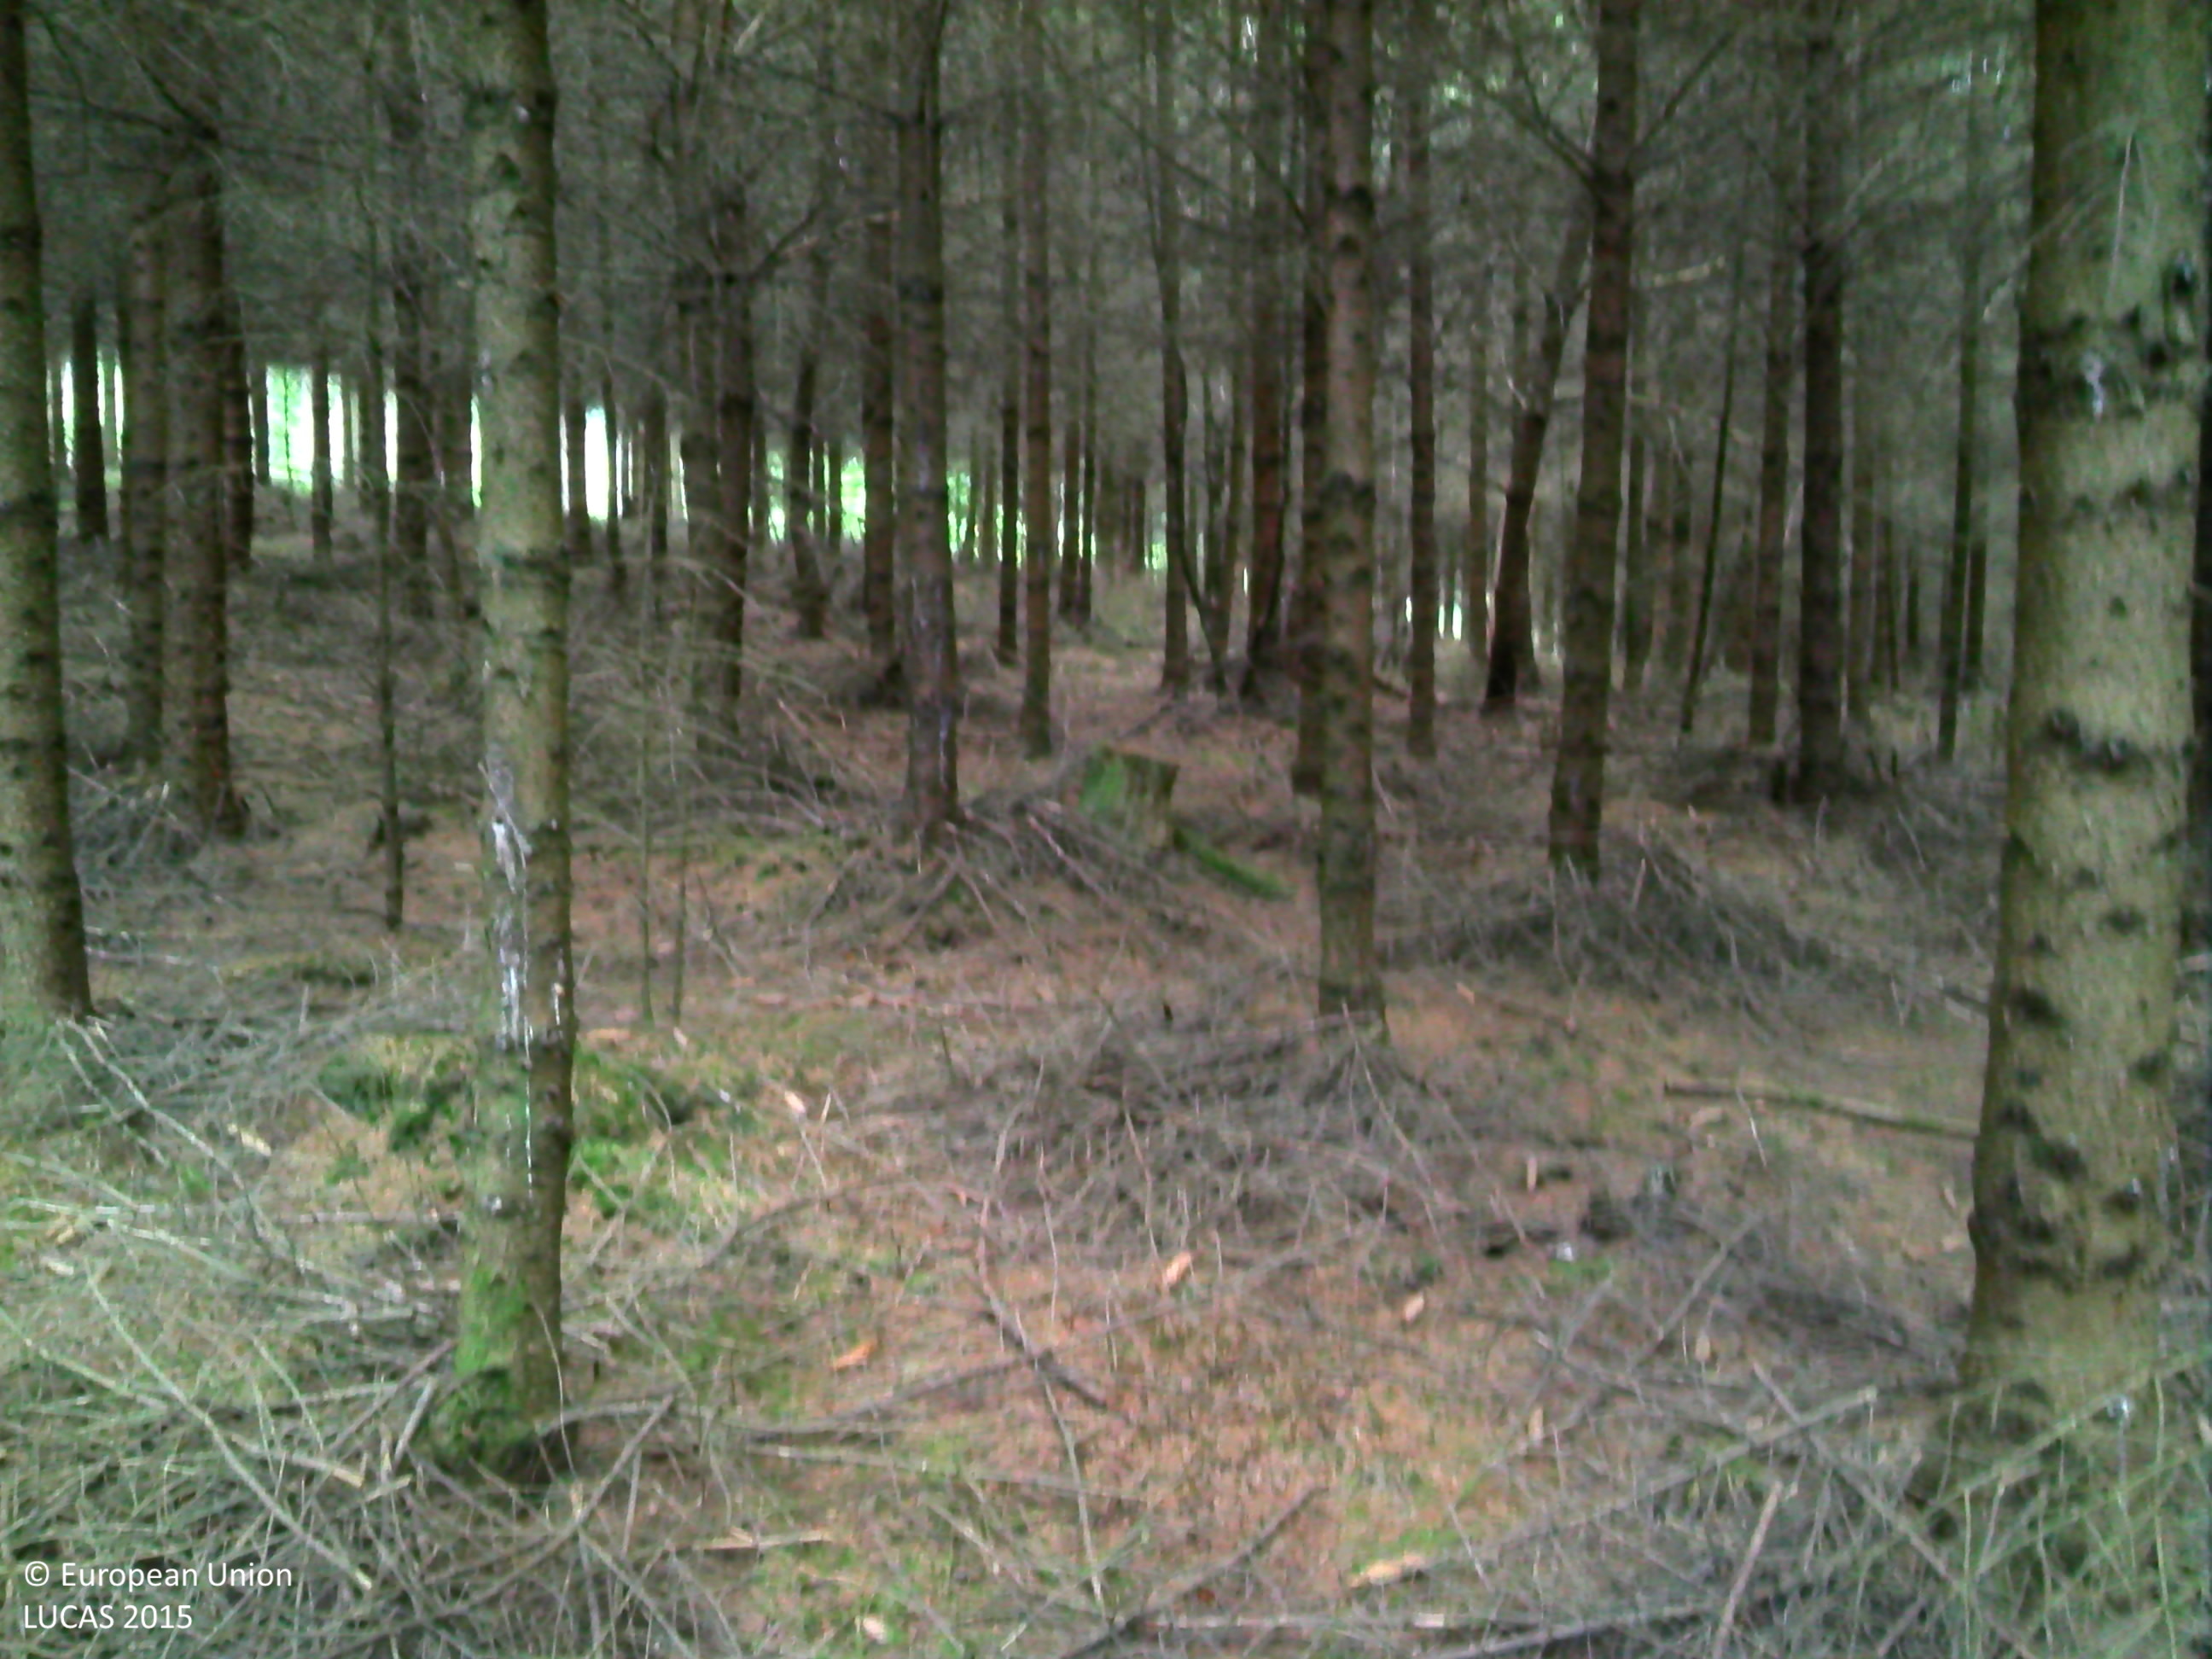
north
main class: Woodland
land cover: Spruce dominated coniferous woodland
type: exotic forest
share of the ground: > 75 %
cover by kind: coniferous forest trees 90 %, lichens and mosses 10 %
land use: Forestry
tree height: > 5 m
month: July
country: BE
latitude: 50.2658
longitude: 6.2256
